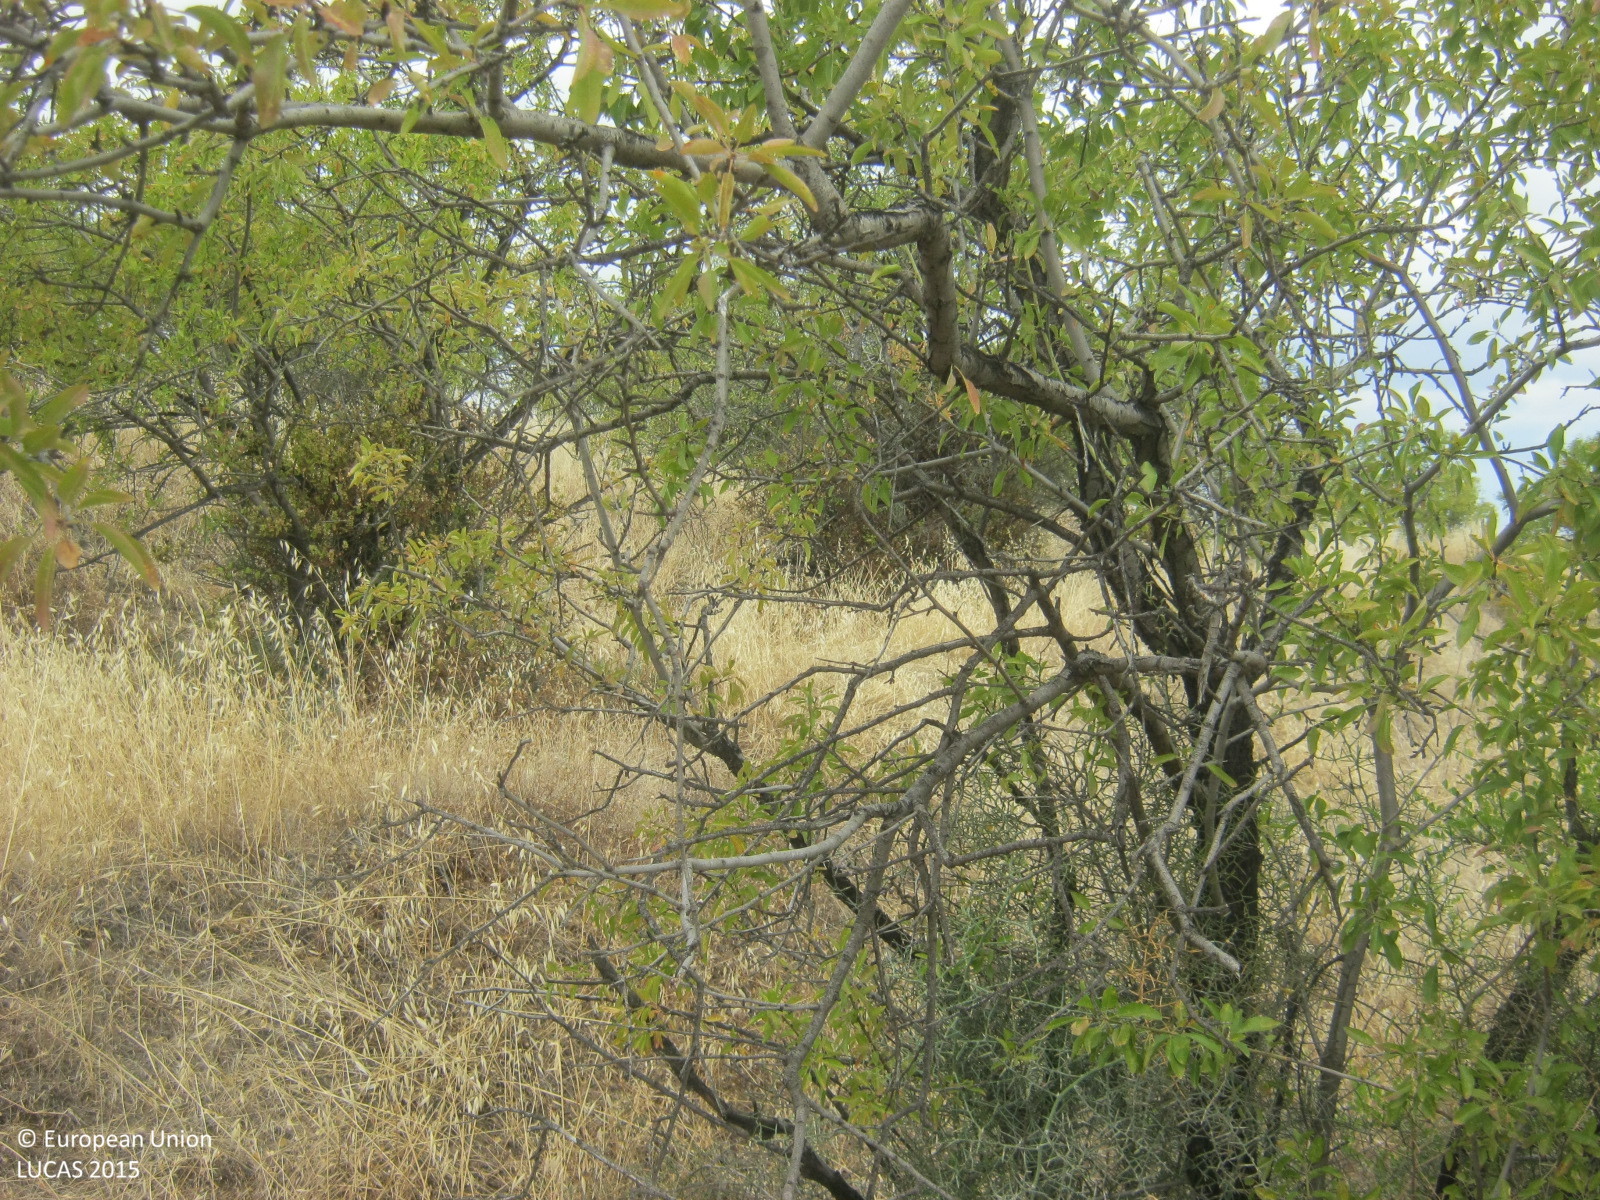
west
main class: Cropland
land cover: Nuts trees
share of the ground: 25 - 50 %
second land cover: Grassland without tree/shrub cover
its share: > 75 %
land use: Agriculture (excluding fallow land and kitchen gardens)
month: June
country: CY
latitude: 35.0625
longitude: 32.9028
